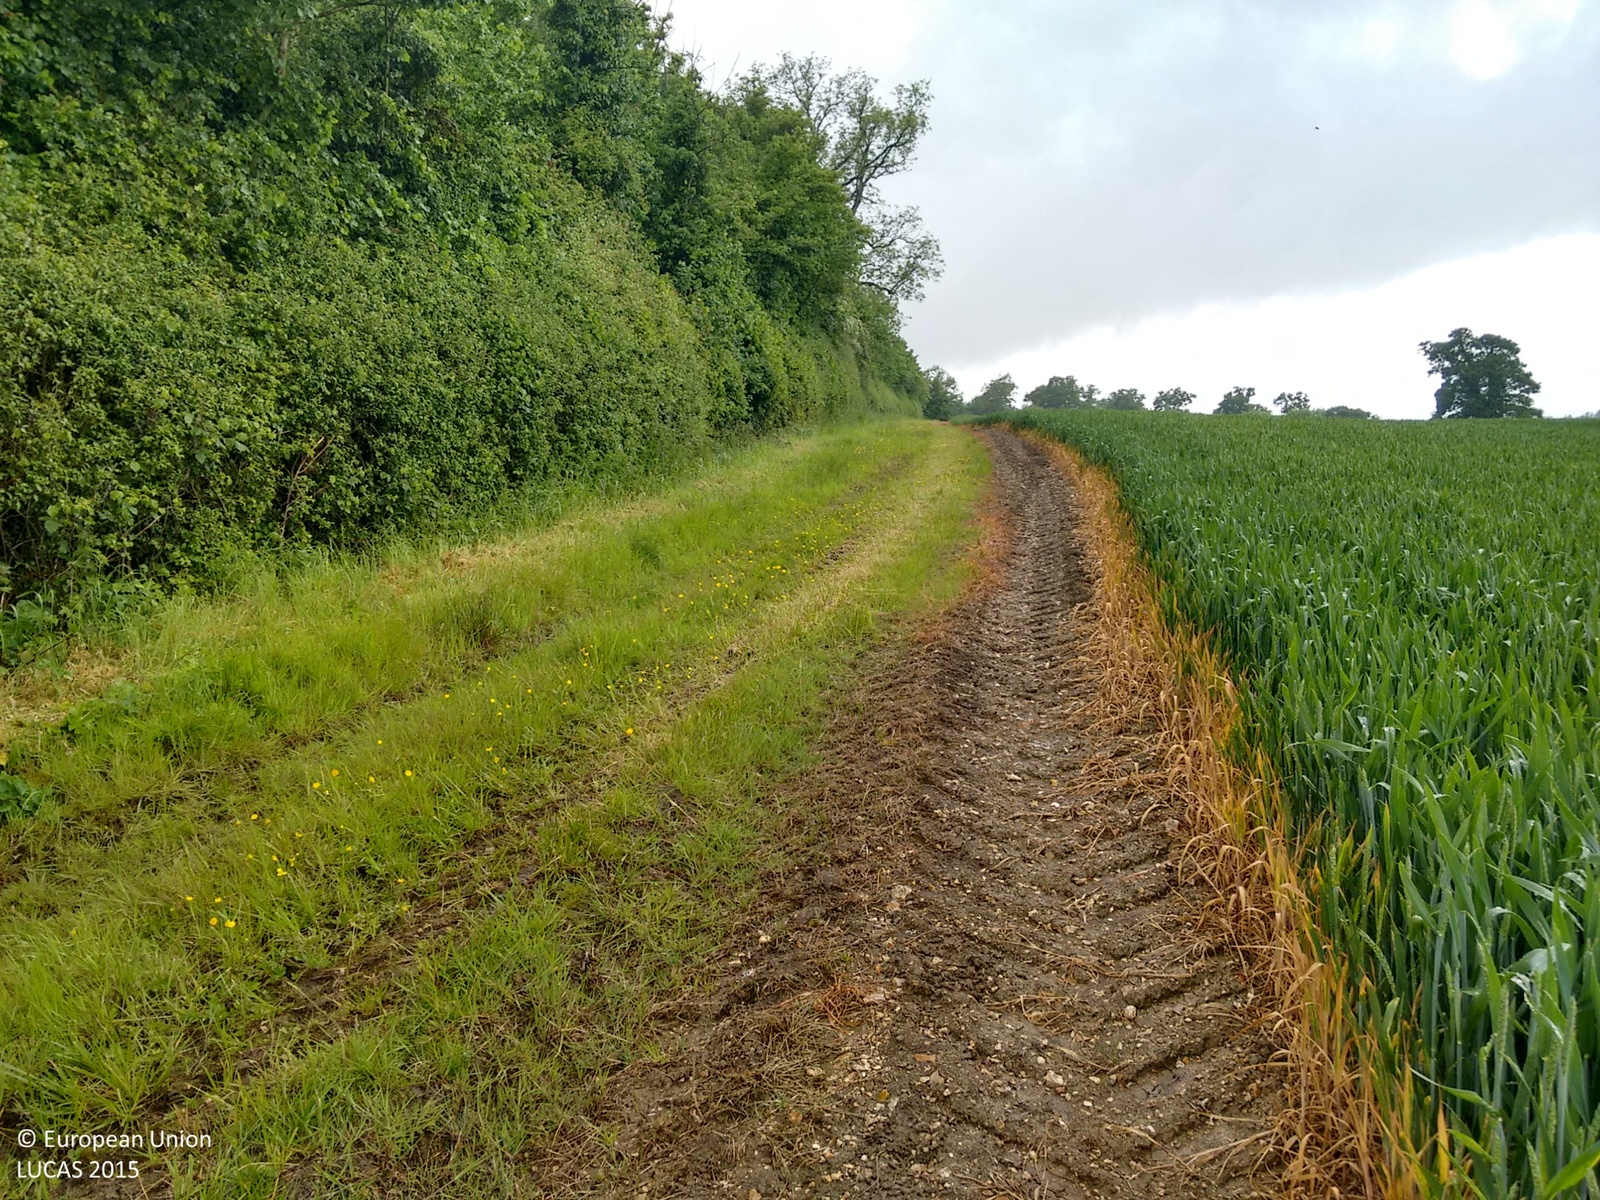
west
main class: Cropland
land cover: Common wheat
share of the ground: > 75 %
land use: Agriculture (excluding fallow land and kitchen gardens)
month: May
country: GB
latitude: 50.9181
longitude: -2.2816
